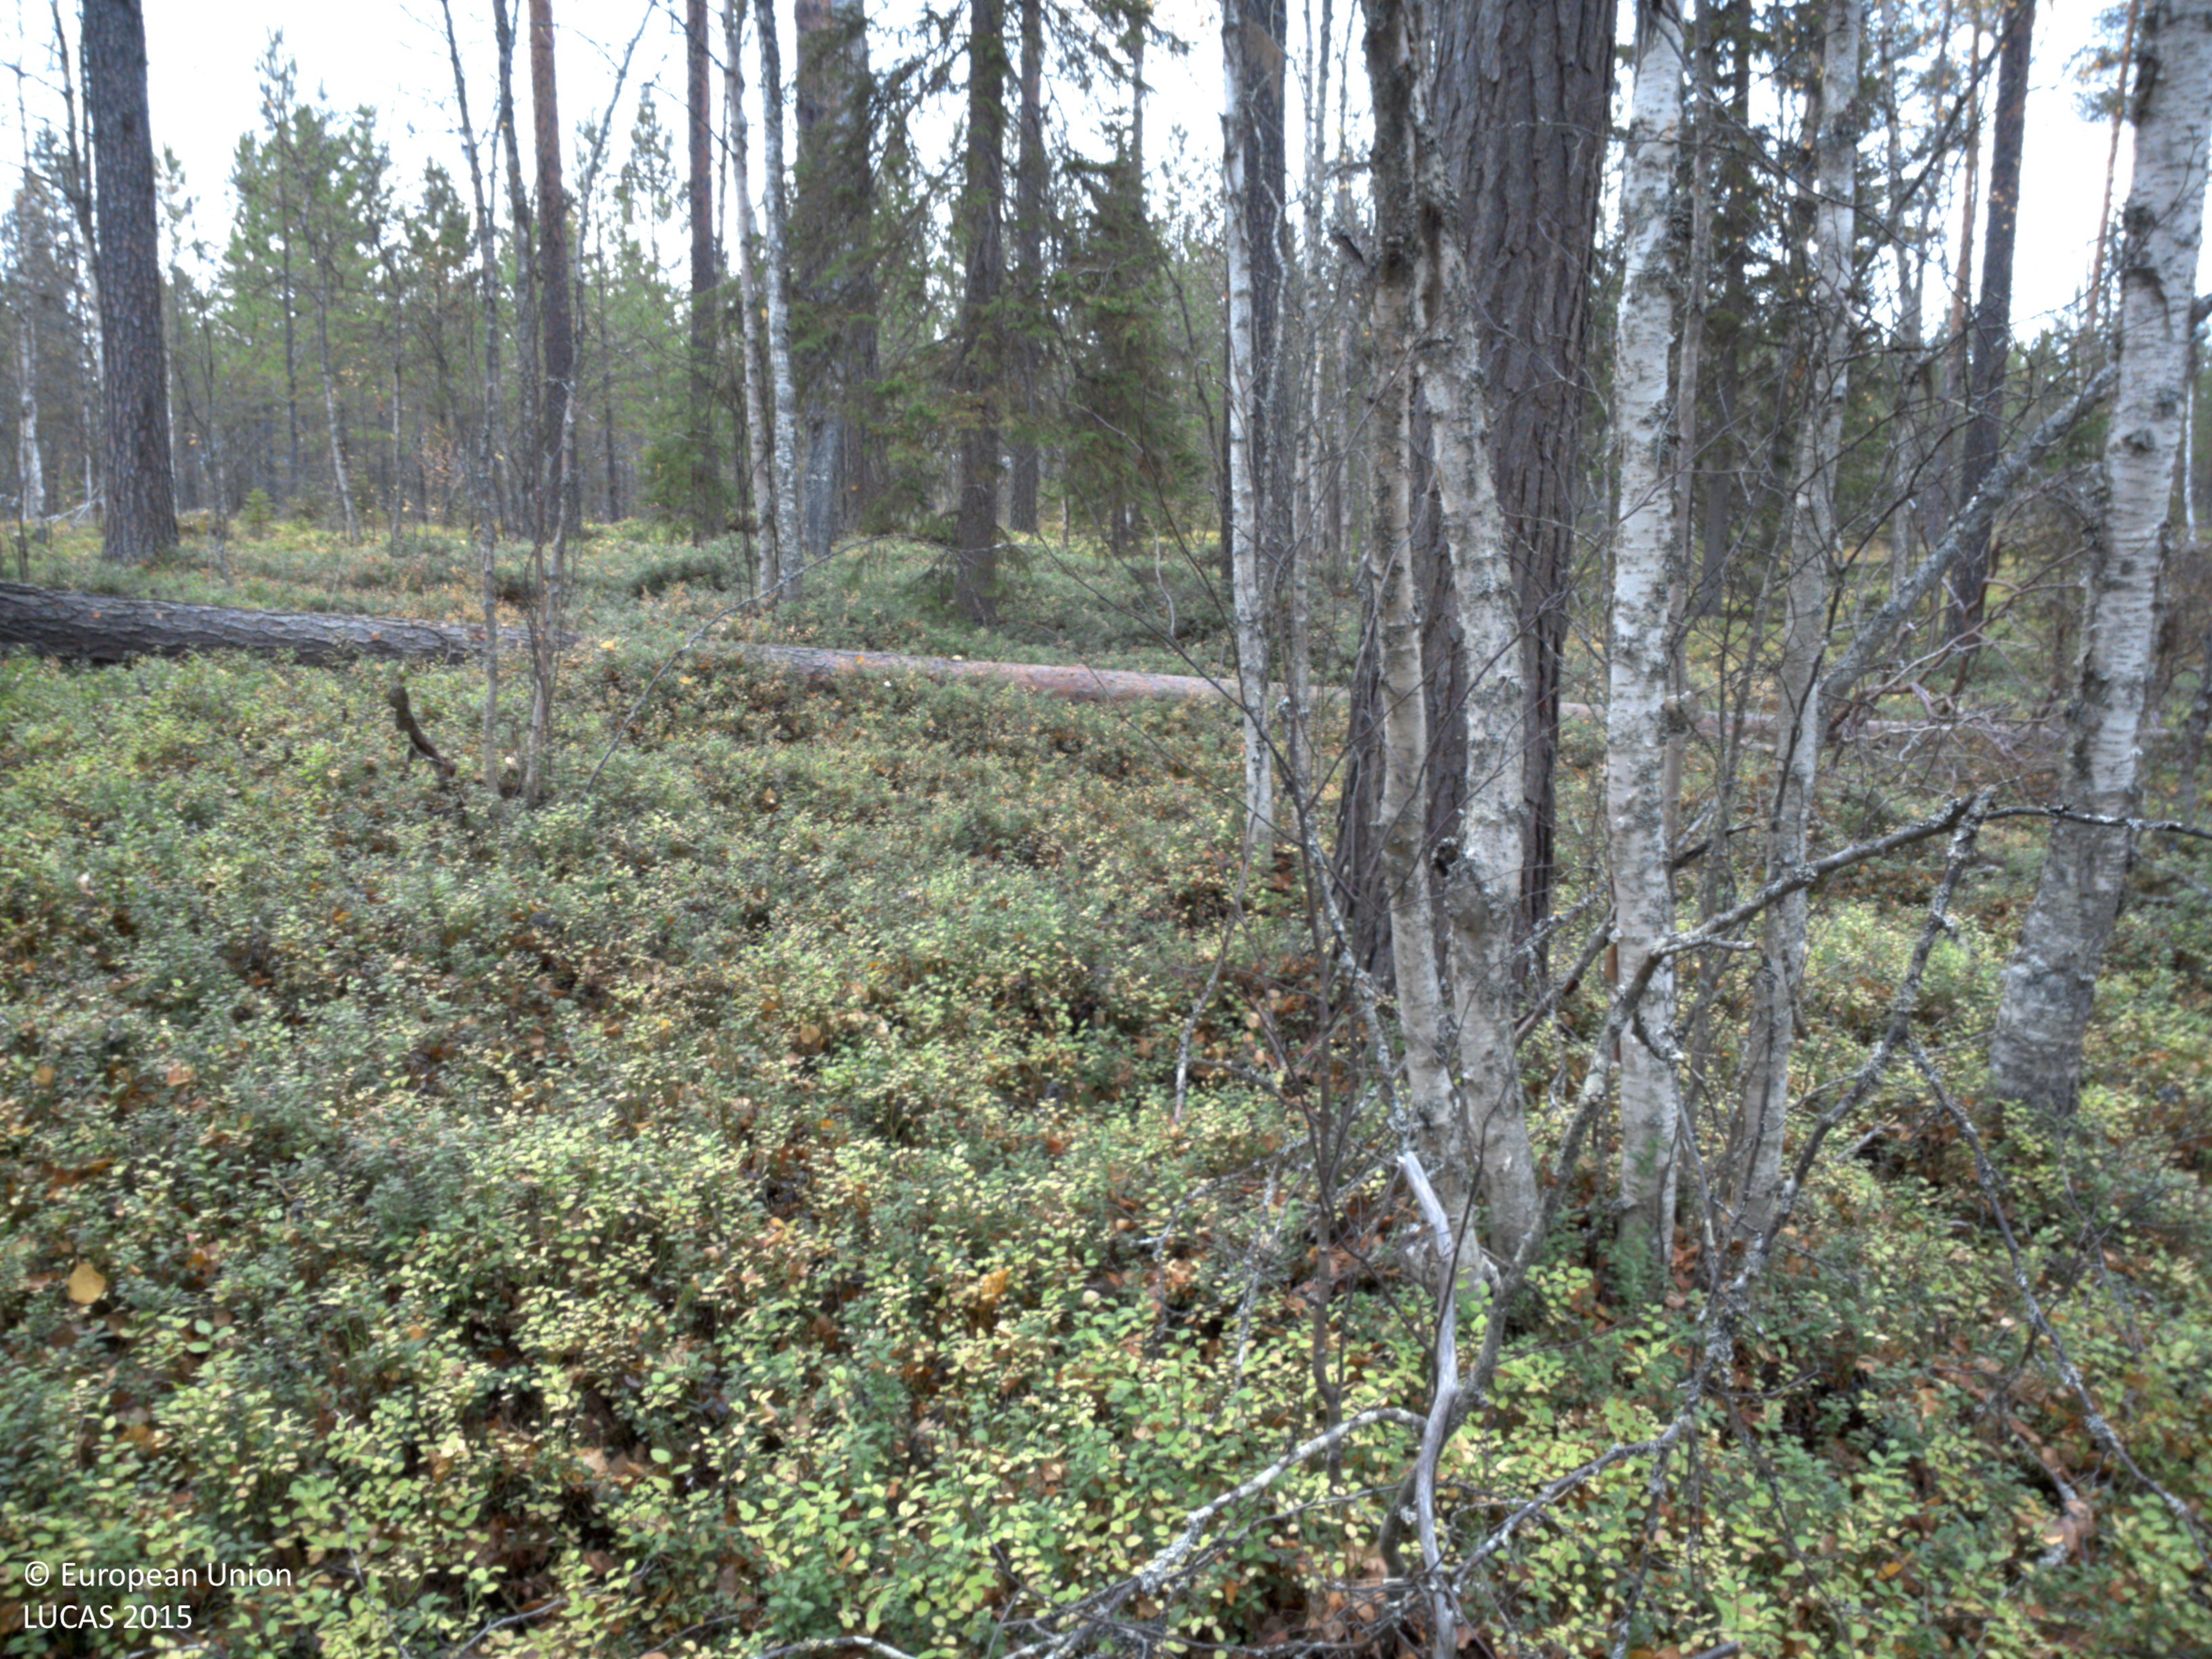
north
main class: Woodland
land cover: Pine dominated mixed woodland
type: boreal forest
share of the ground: 50 - 75 %
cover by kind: coniferous forest trees 50 %, broadleaved forest trees 25 %, shrubs 15 %, lichens and mosses 10 %
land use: Forestry
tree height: > 5 m
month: October
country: SE
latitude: 64.7882
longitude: 18.1502
